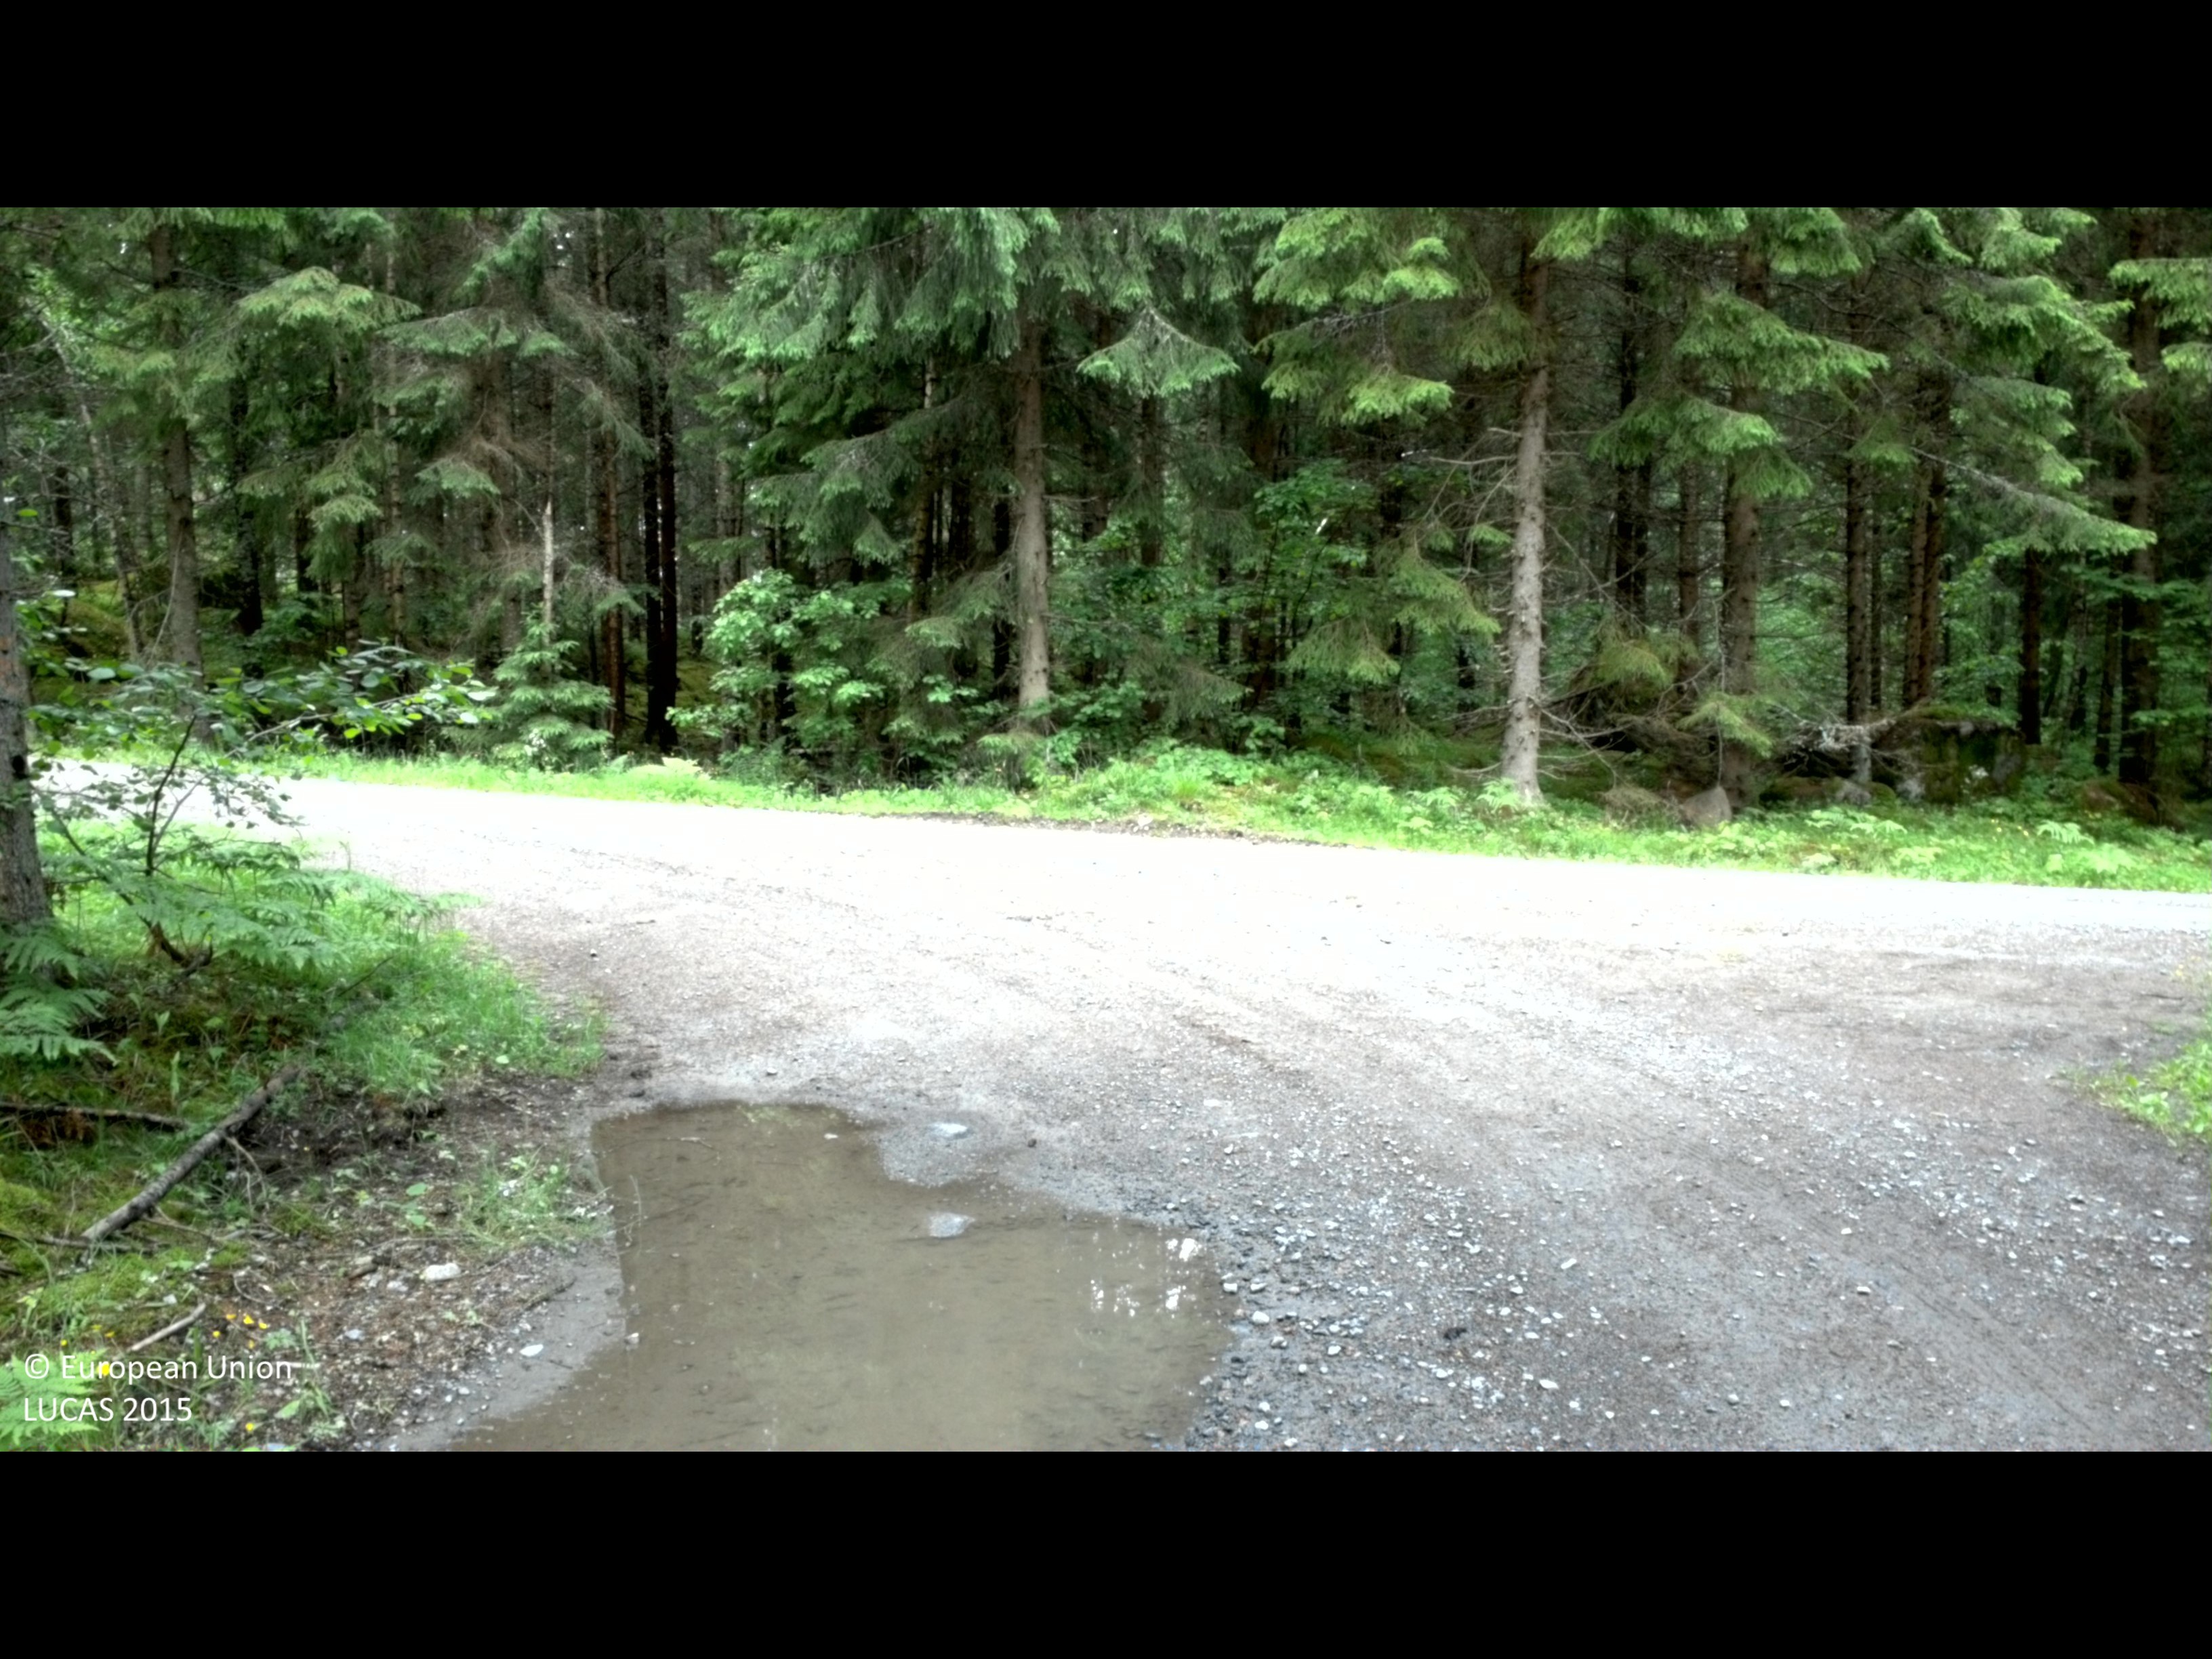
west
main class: Woodland
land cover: Spruce dominated coniferous woodland
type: boreal forest
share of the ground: > 75 %
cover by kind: coniferous forest trees 75 %, shrubs 10 %, lichens and mosses 10 %, broadleaved forest trees 5 %
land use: Forestry
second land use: Sport
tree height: > 5 m
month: June
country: SE
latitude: 58.0818
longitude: 16.0843
